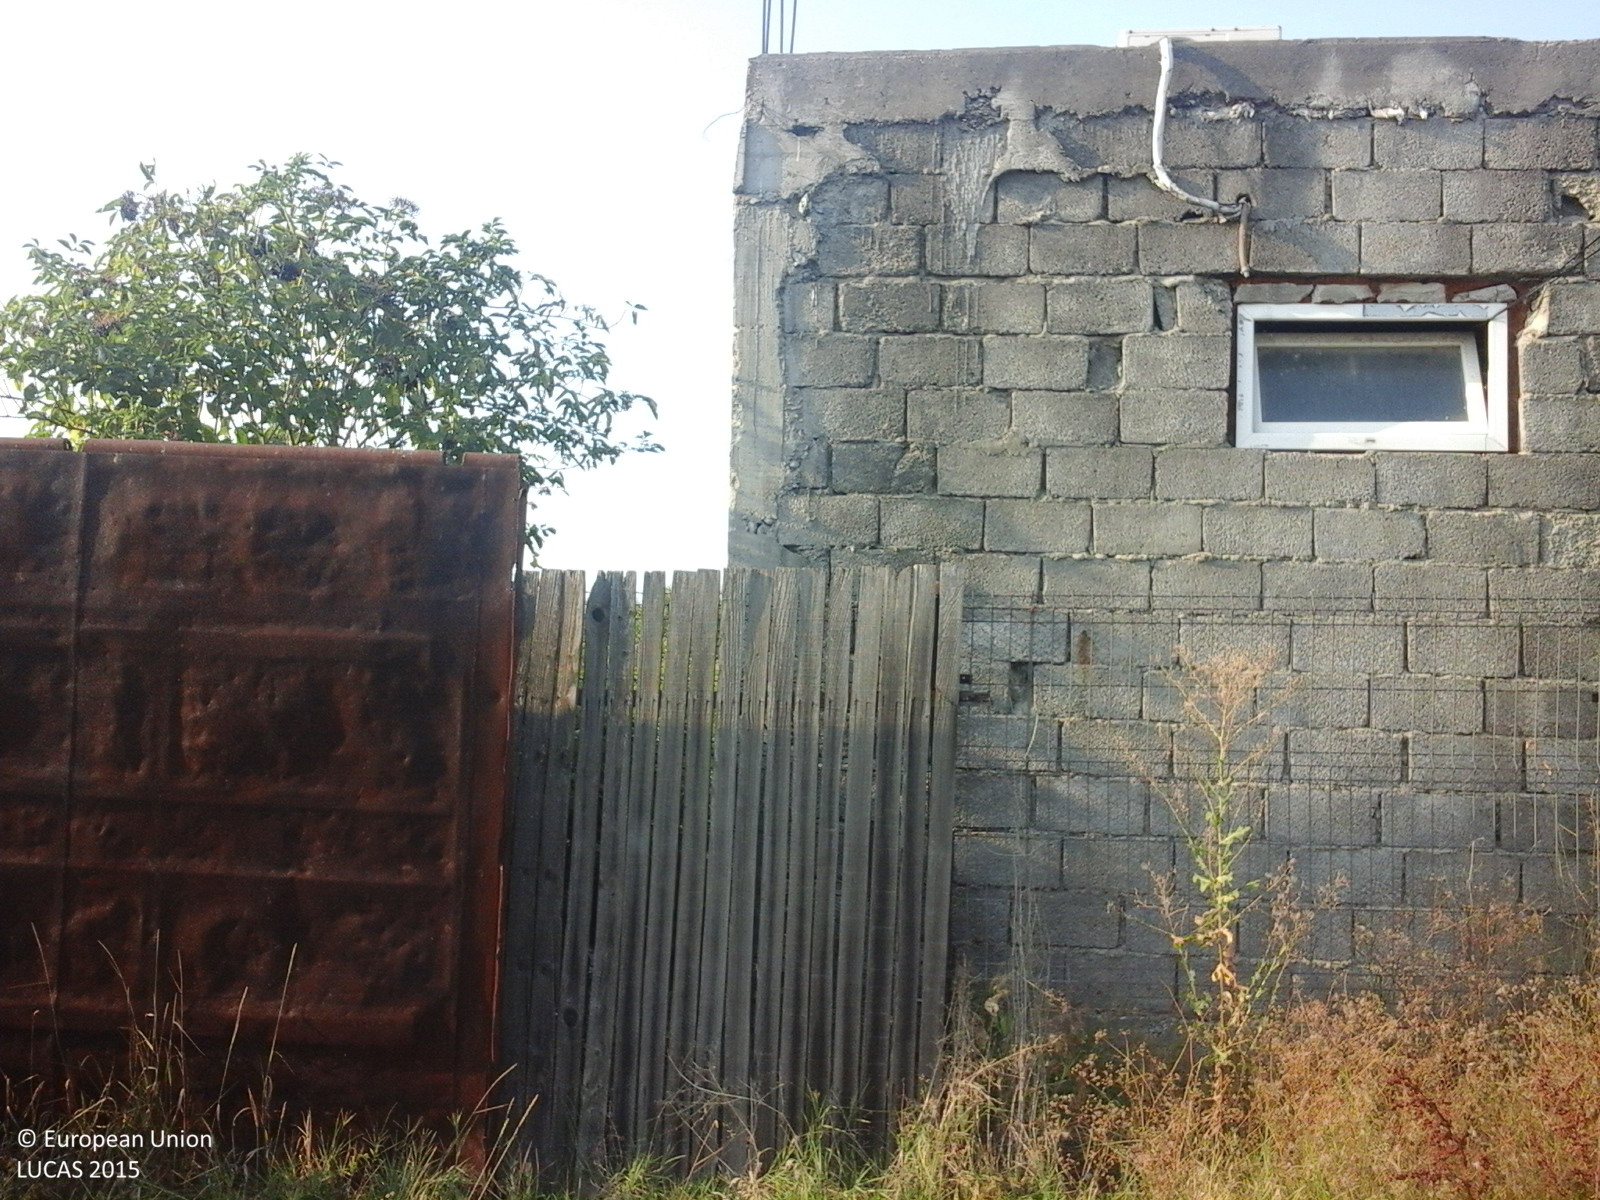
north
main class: Grassland
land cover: Spontaneously vegetated surfaces
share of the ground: > 75 %
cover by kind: herbaceous plants 100 %
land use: Residential
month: August
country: RO
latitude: 44.3528
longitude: 23.8198
